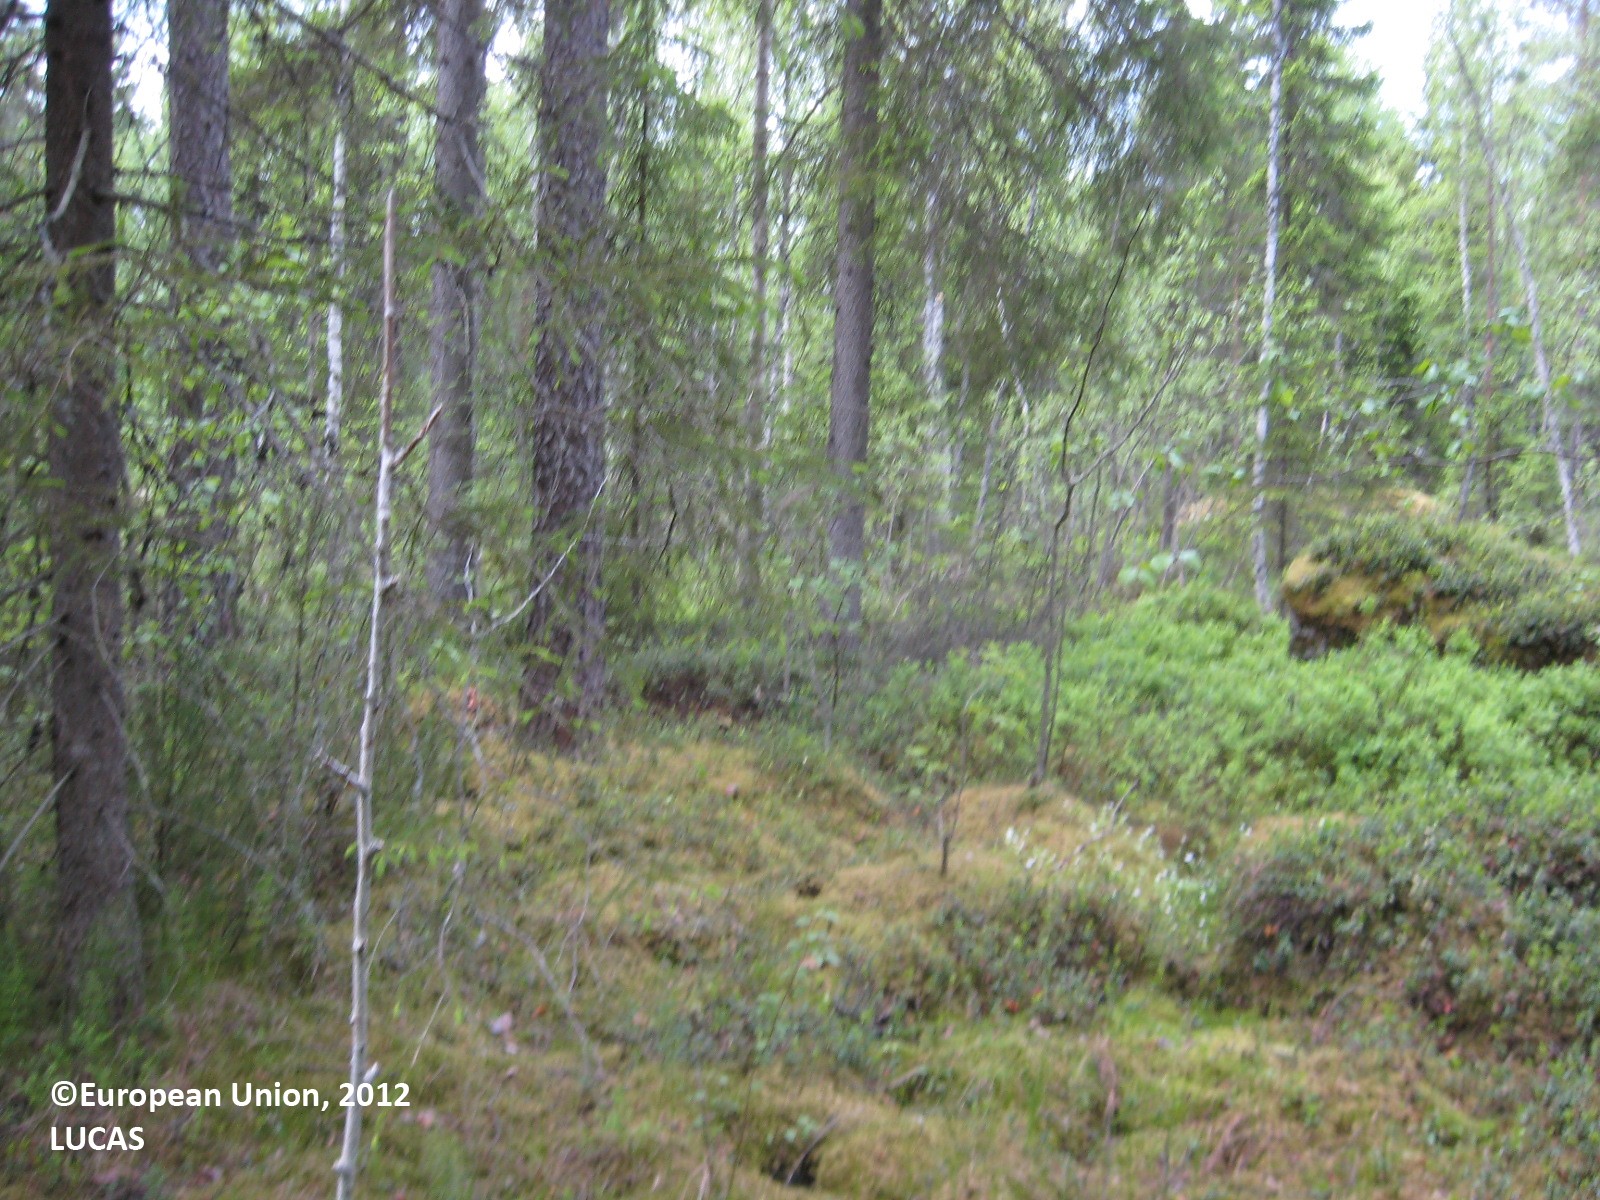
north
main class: Woodland
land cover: Spruce dominated mixed woodland
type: boreal forest
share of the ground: > 75 %
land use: Forestry
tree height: > 5 m
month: June
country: FI
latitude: 63.0579
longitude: 22.7351
